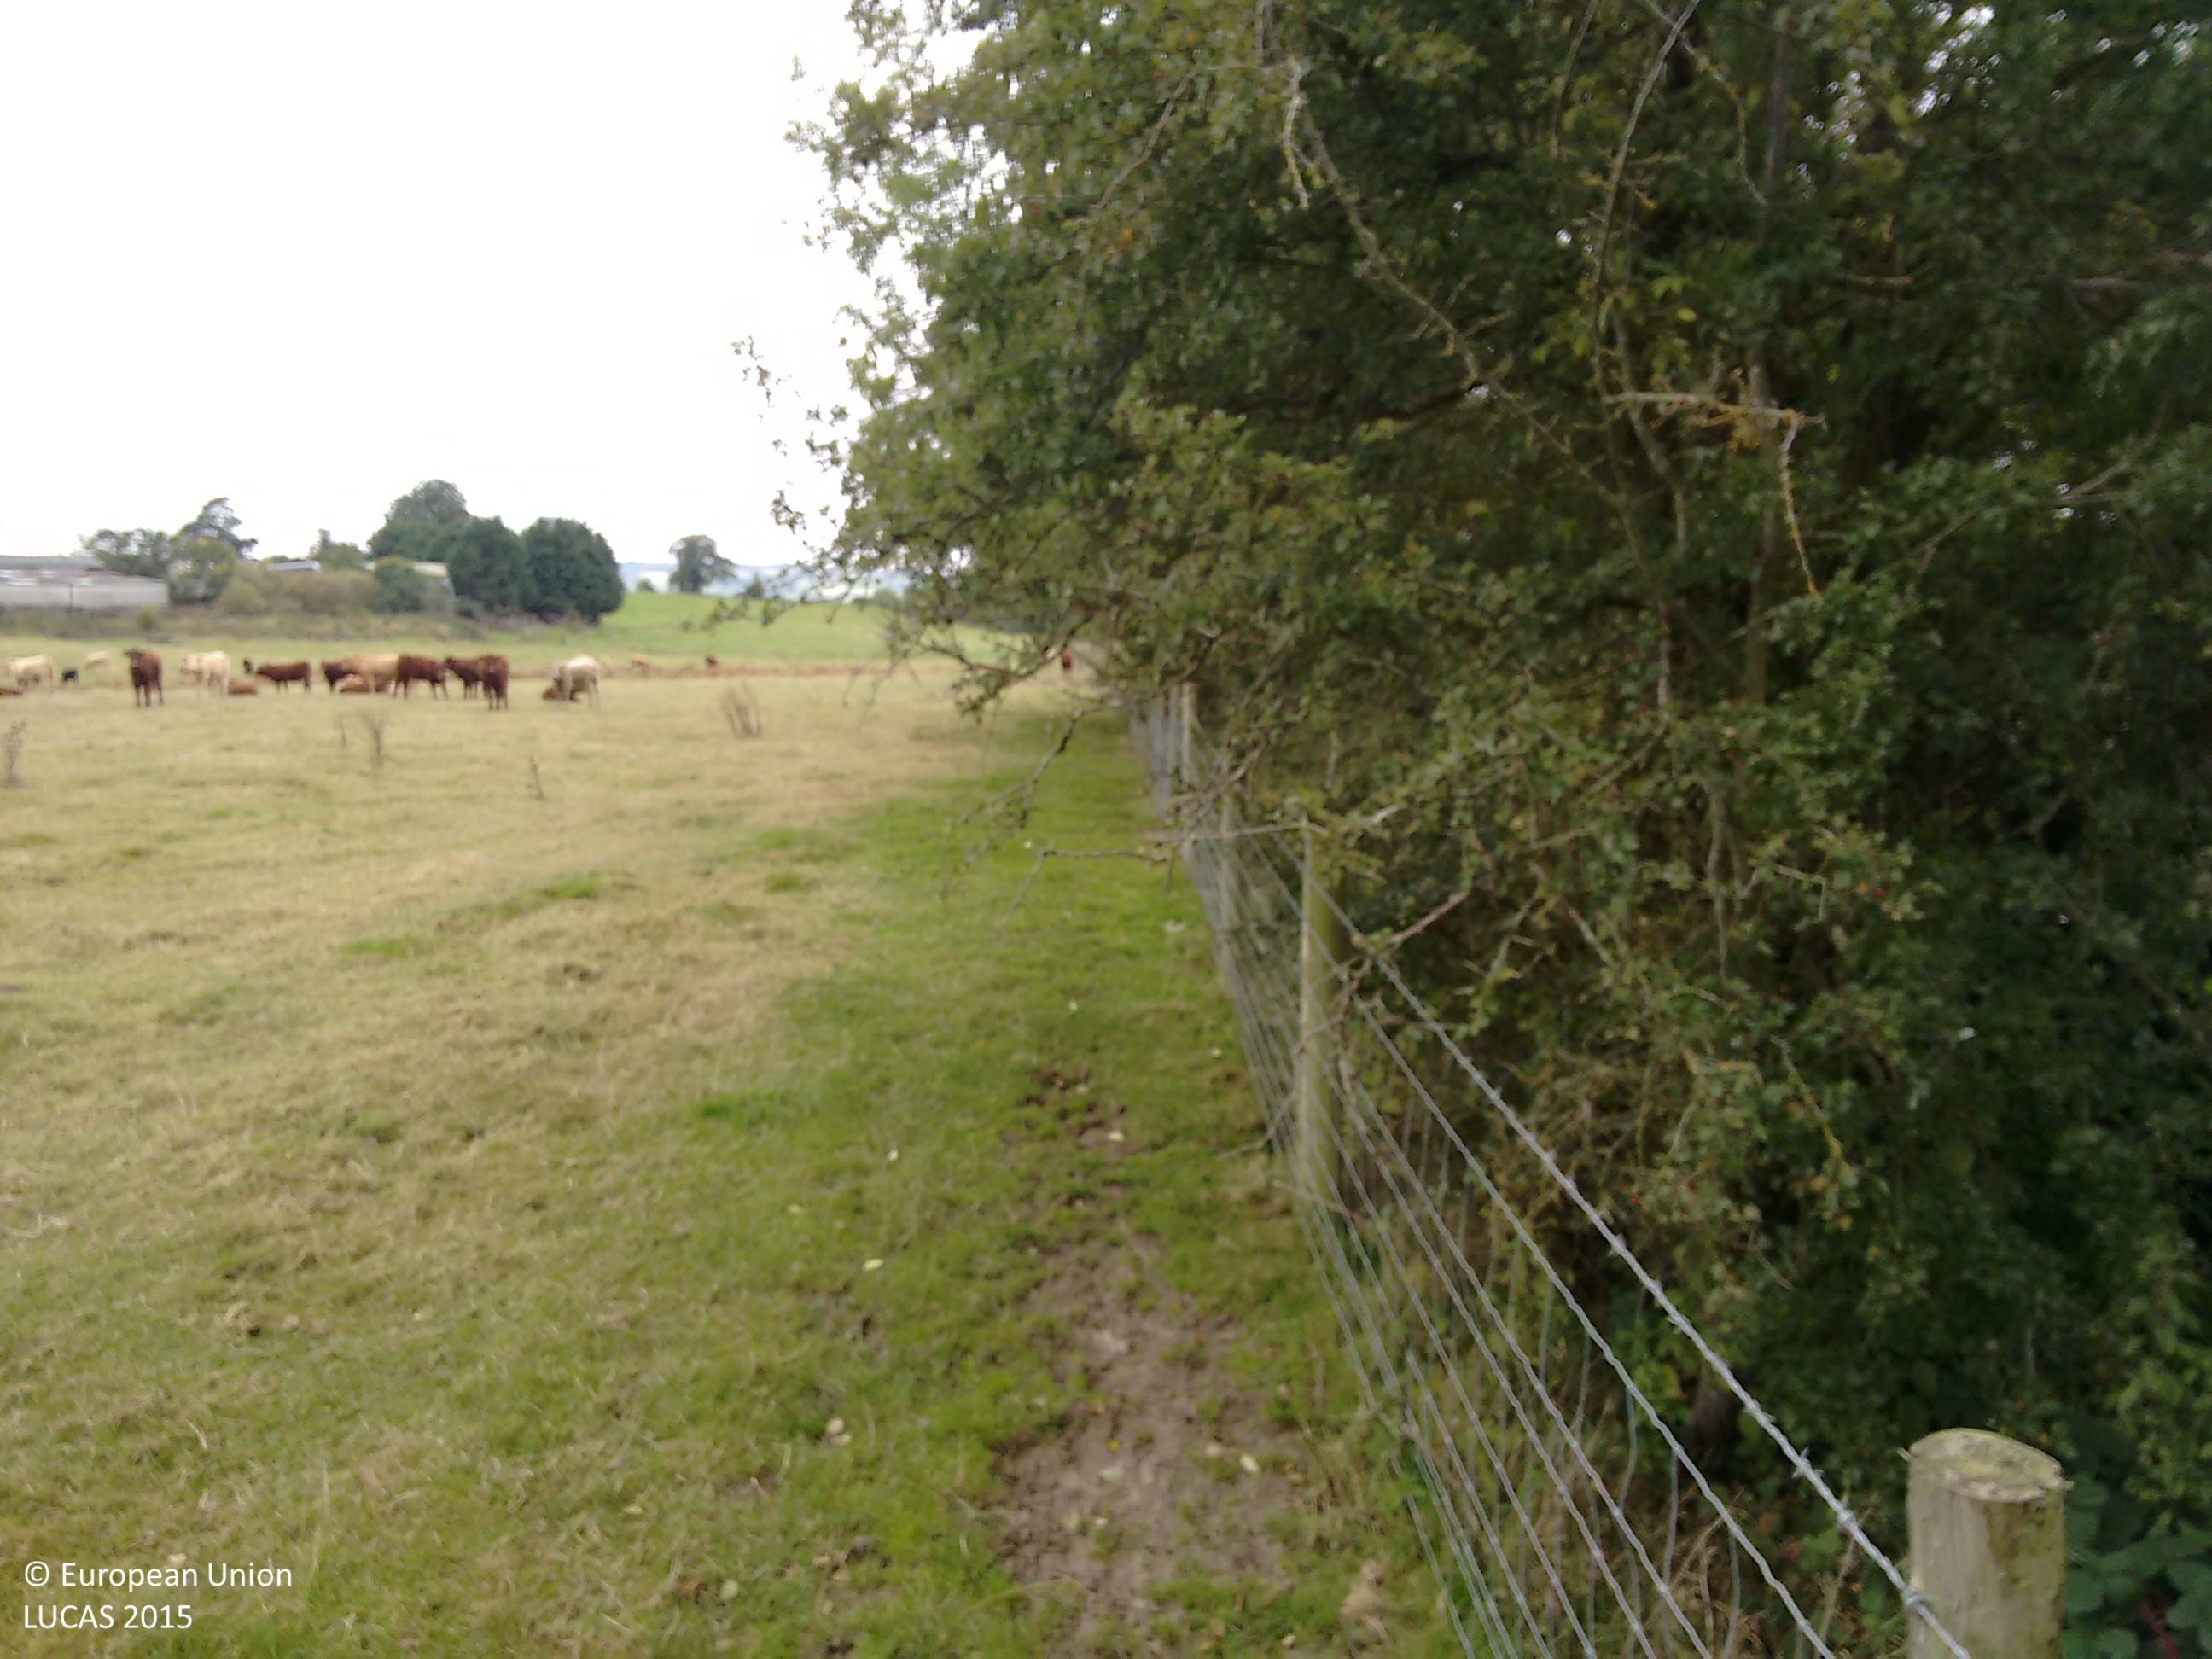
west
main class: Grassland
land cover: Grassland without tree/shrub cover
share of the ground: > 75 %
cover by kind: herbaceous plants 100 %
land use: Agriculture (excluding fallow land and kitchen gardens)
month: September
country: GB
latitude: 52.8953
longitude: -3.0222
